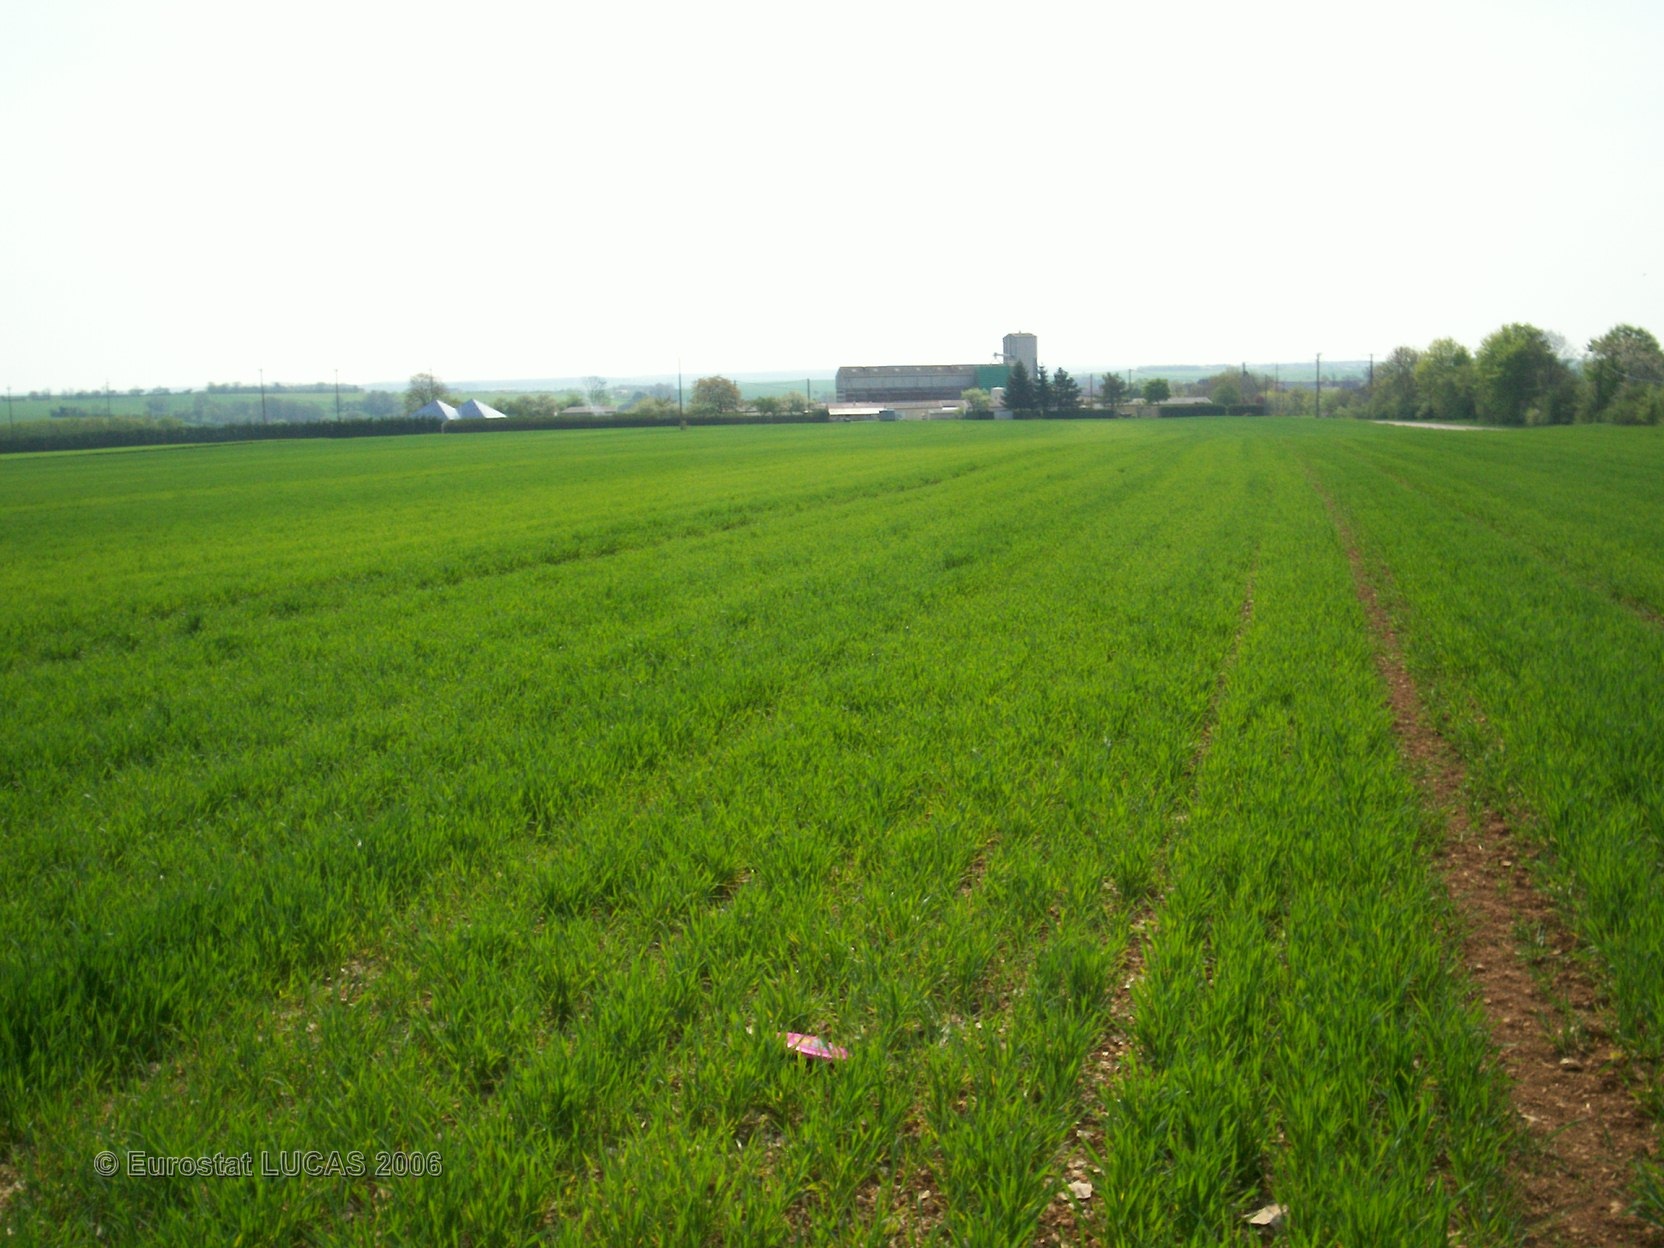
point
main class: Cropland
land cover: Common wheat
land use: Agriculture (excluding fallow land and kitchen gardens)
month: May
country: FR
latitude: 47.6061
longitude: 4.6385
